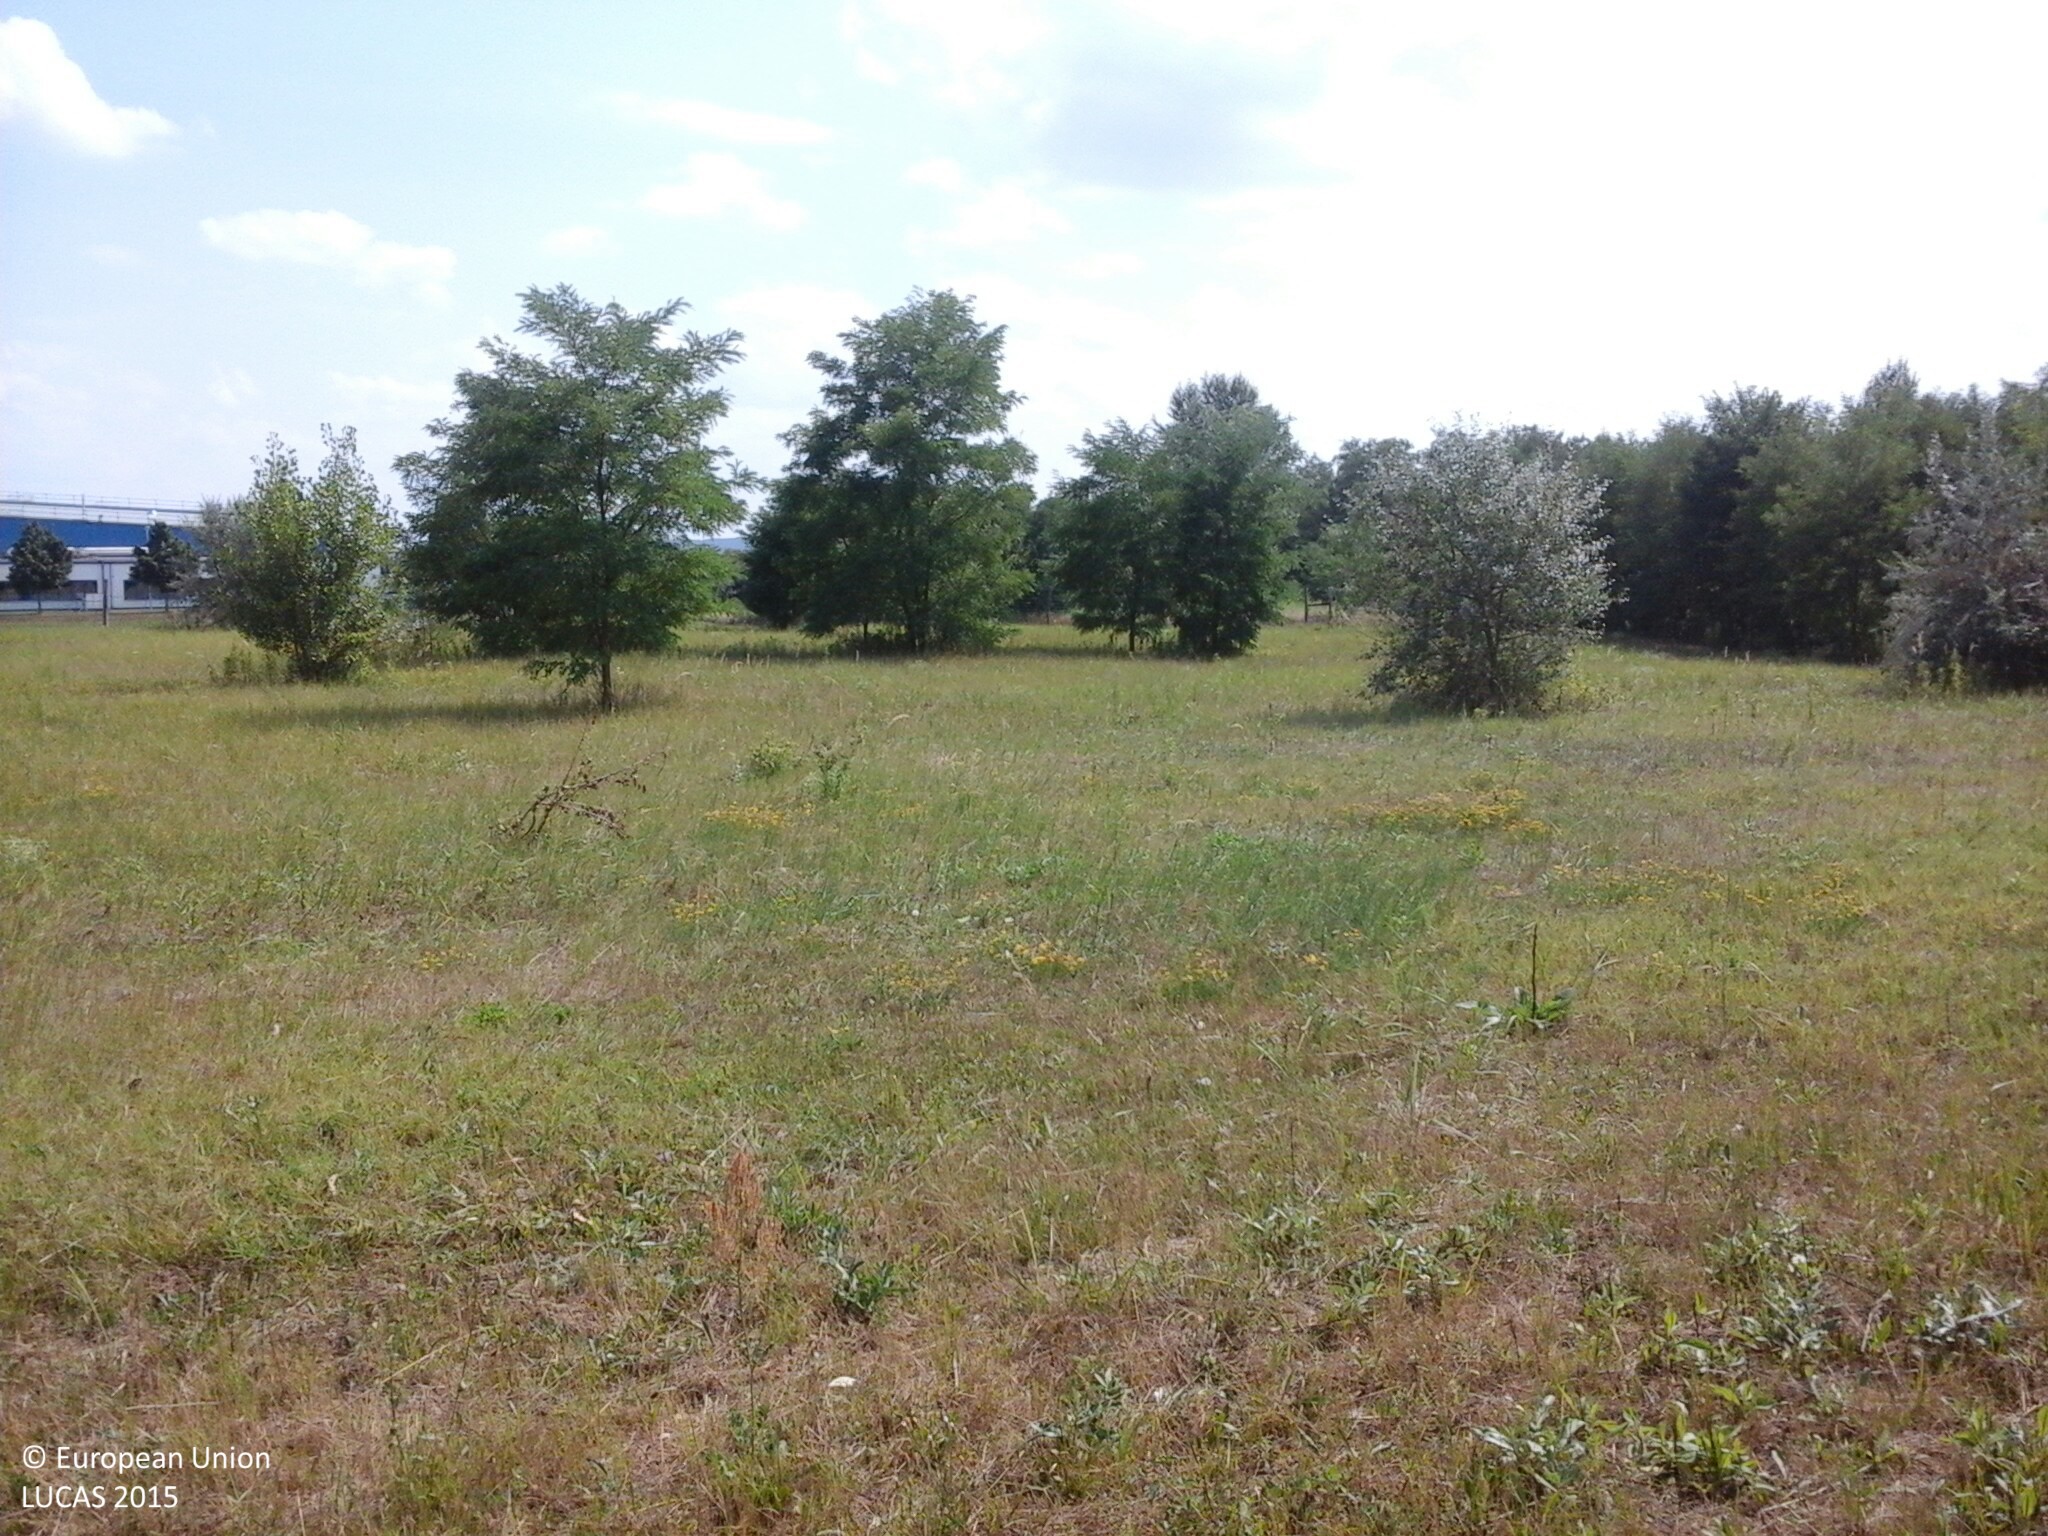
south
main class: Grassland
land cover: Grassland without tree/shrub cover
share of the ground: > 75 %
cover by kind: herbaceous plants 100 %
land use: Semi-natural and natural areas not in use
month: August
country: HU
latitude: 47.3763
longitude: 18.1831
